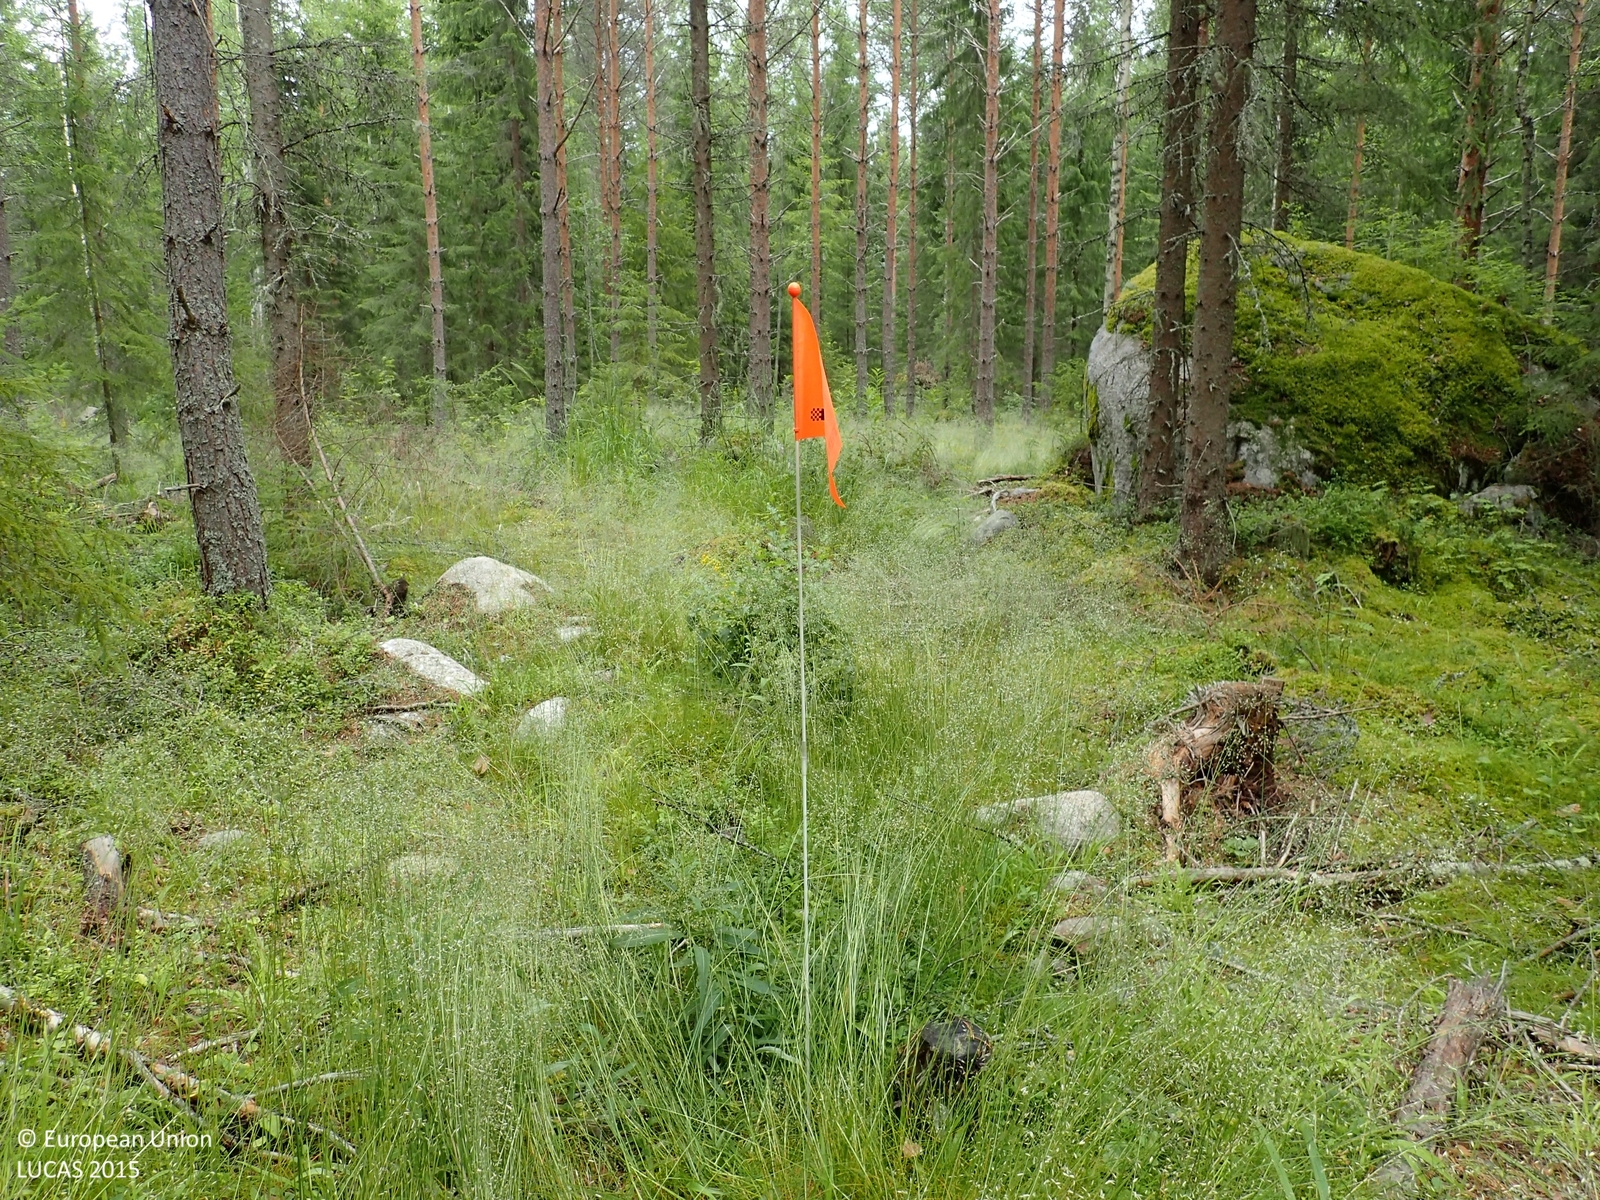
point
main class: Woodland
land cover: Other coniferous woodland
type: boreal forest
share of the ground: 50 - 75 %
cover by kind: coniferous forest trees 50 %, shrubs 25 %, herbaceous plants 10 %, lichens and mosses 10 %, broadleaved forest trees 5 %
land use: Forestry
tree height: > 5 m
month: July
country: FI
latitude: 62.8535
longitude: 22.3289
